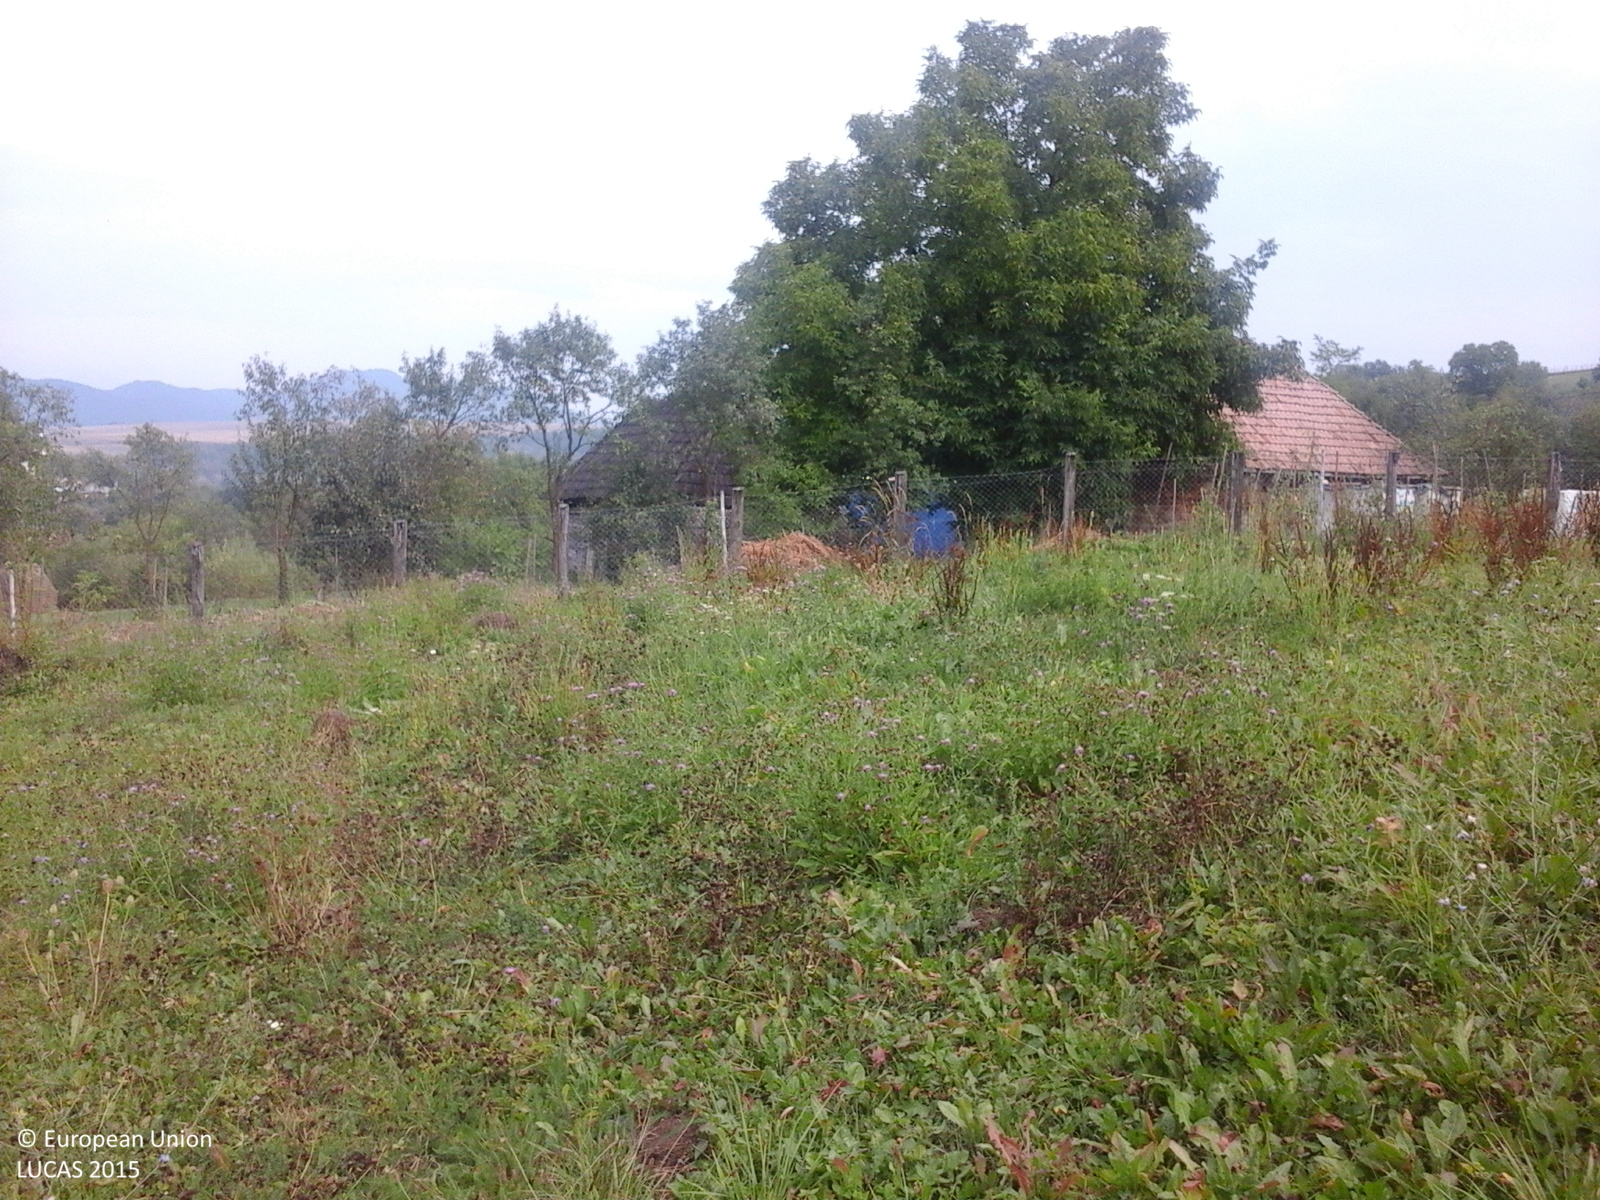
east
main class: Grassland
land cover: Grassland without tree/shrub cover
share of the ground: > 75 %
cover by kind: herbaceous plants 100 %
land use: Agriculture (excluding fallow land and kitchen gardens)
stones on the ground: < 10 %
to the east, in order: Grassland without tree/shrub cover; Fences; Abandoned hedges; Artificial constructions in urban areas; Grassland without tree/shrub cover; Fences; Grassland without tree/shrub cover; Other fresh vegetables; Apple fruit; Fences; Grass margins; Tracks; Grass margins; Fences; Abandoned hedges; Grassland without tree/shrub cover; Broadleaved woodland; Grassland with sparse tree/shrub cover
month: September
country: RO
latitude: 47.8469
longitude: 23.9146
